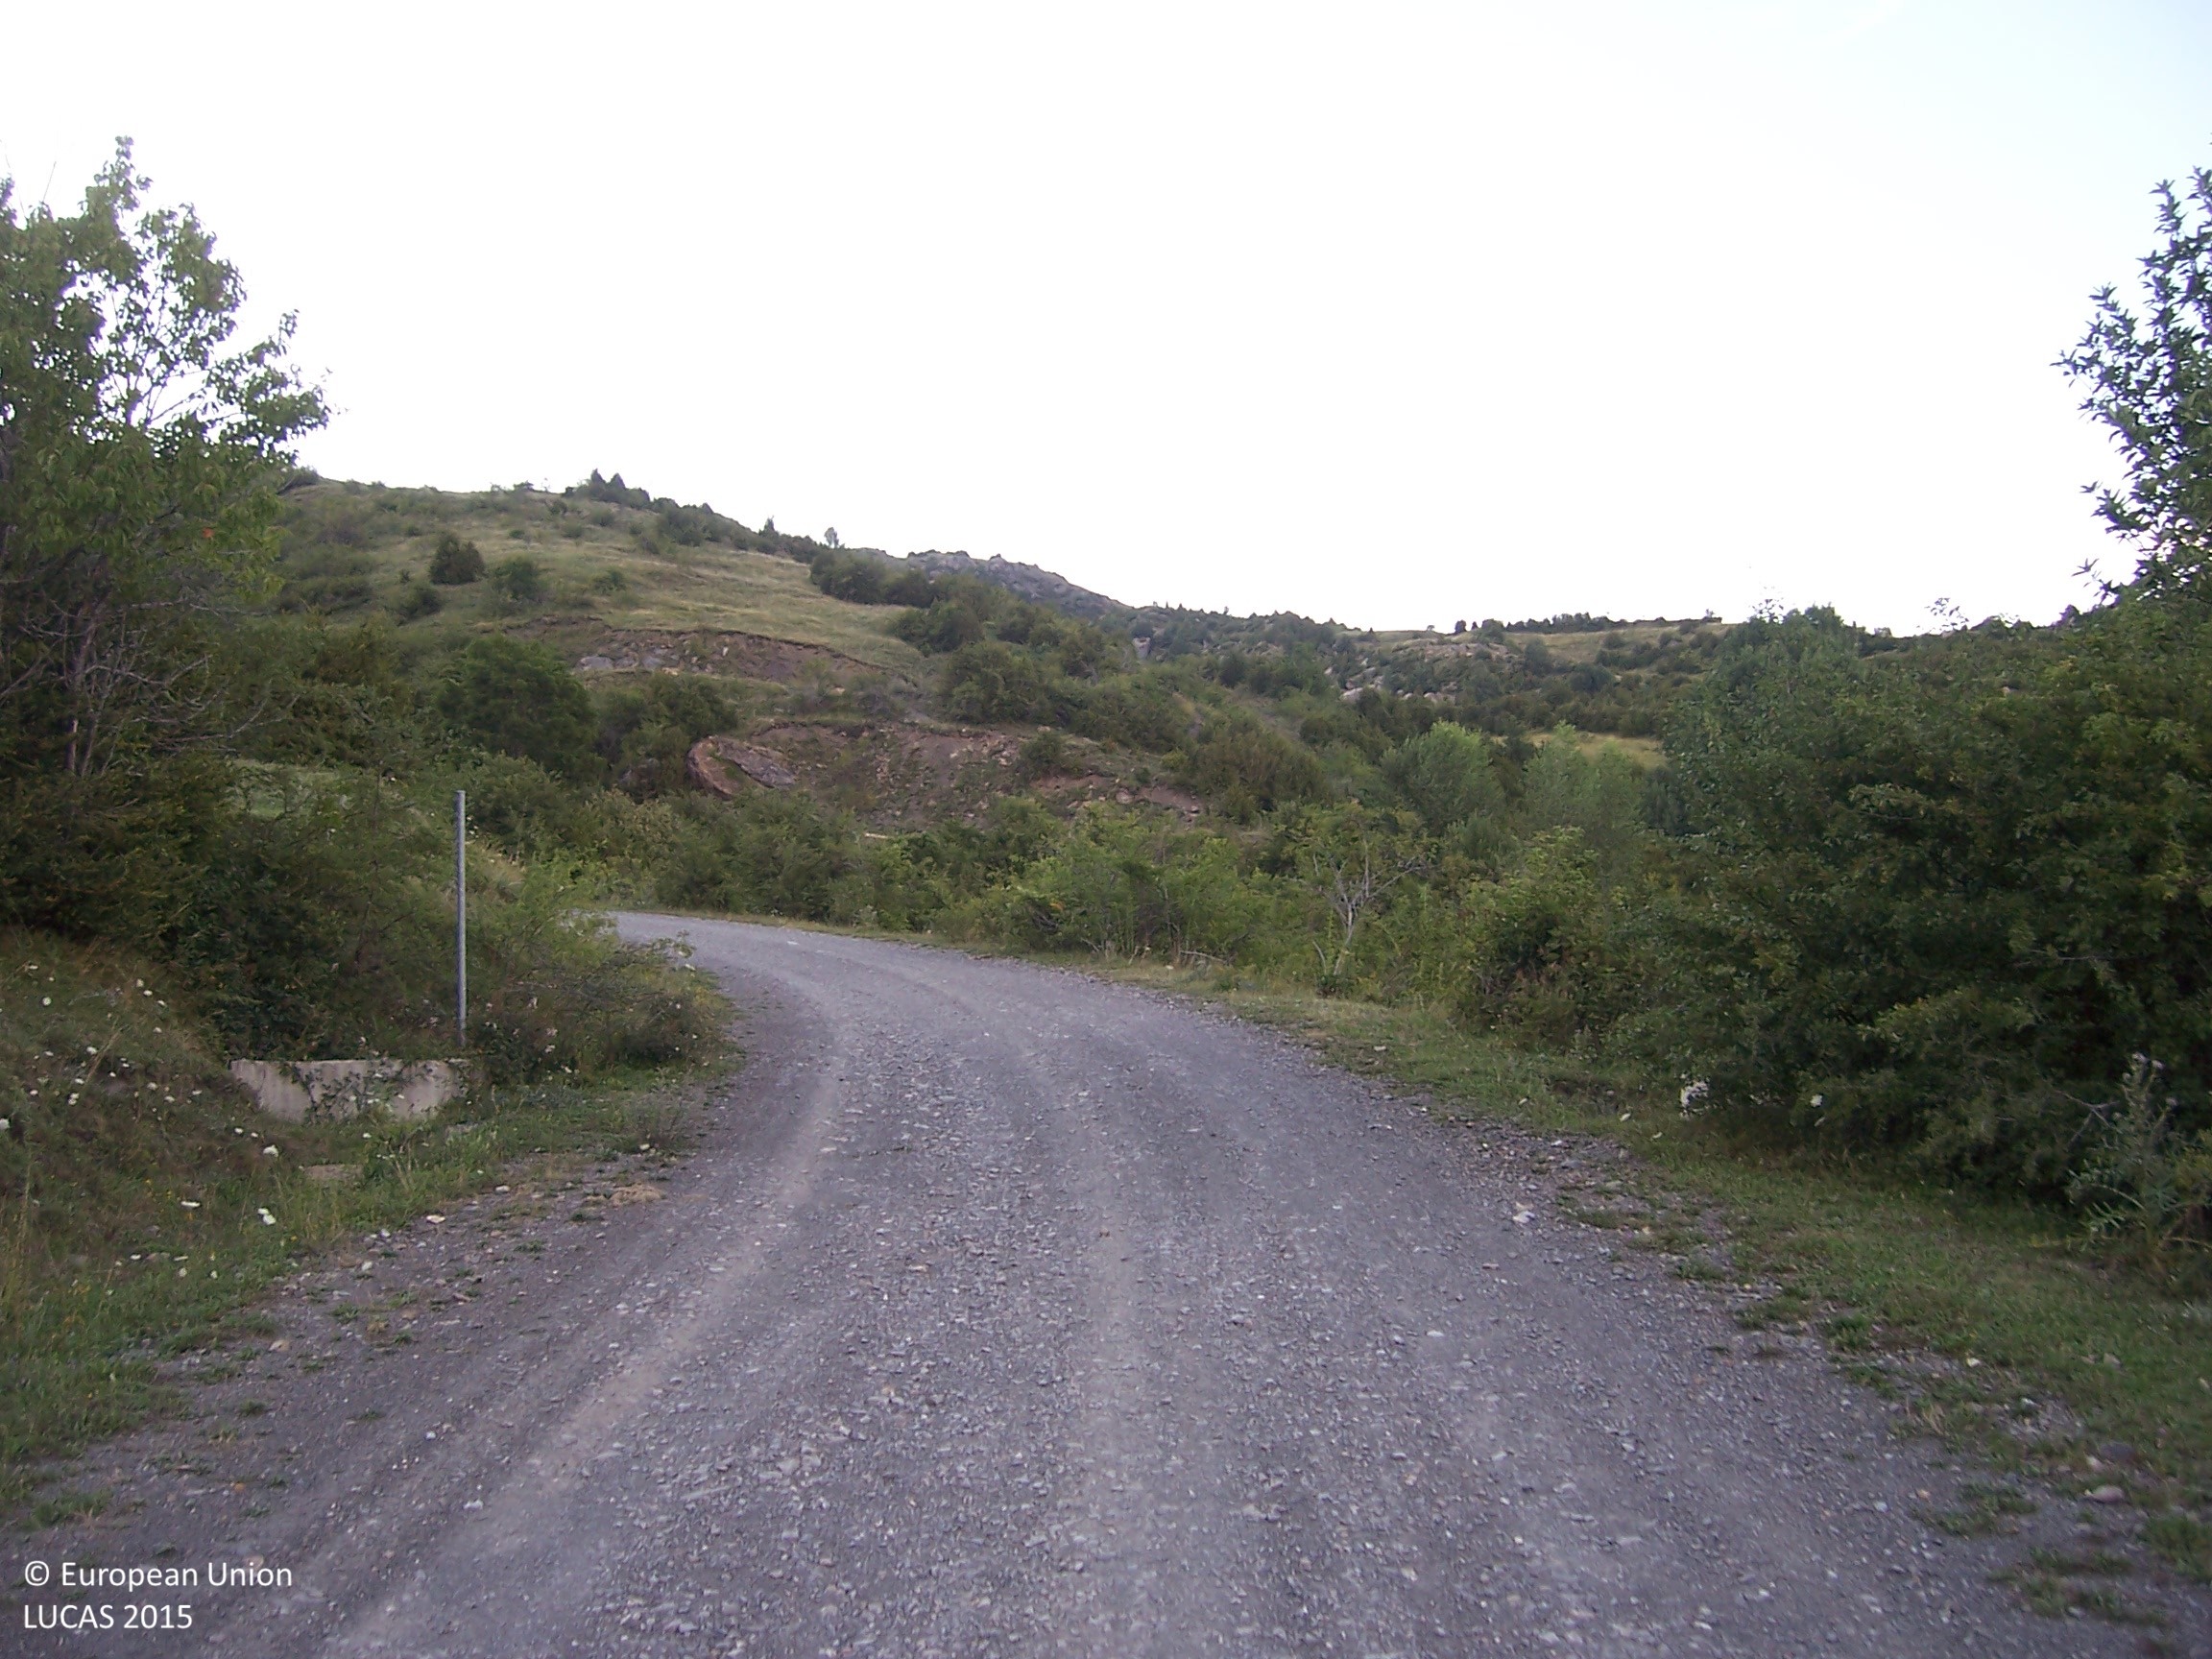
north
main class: Grassland
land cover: Grassland without tree/shrub cover
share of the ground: > 75 %
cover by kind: herbaceous plants 60 %, consolidated bare surface 40 %
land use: Agriculture (excluding fallow land and kitchen gardens)
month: August
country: ES
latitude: 42.7385
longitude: -0.3733
